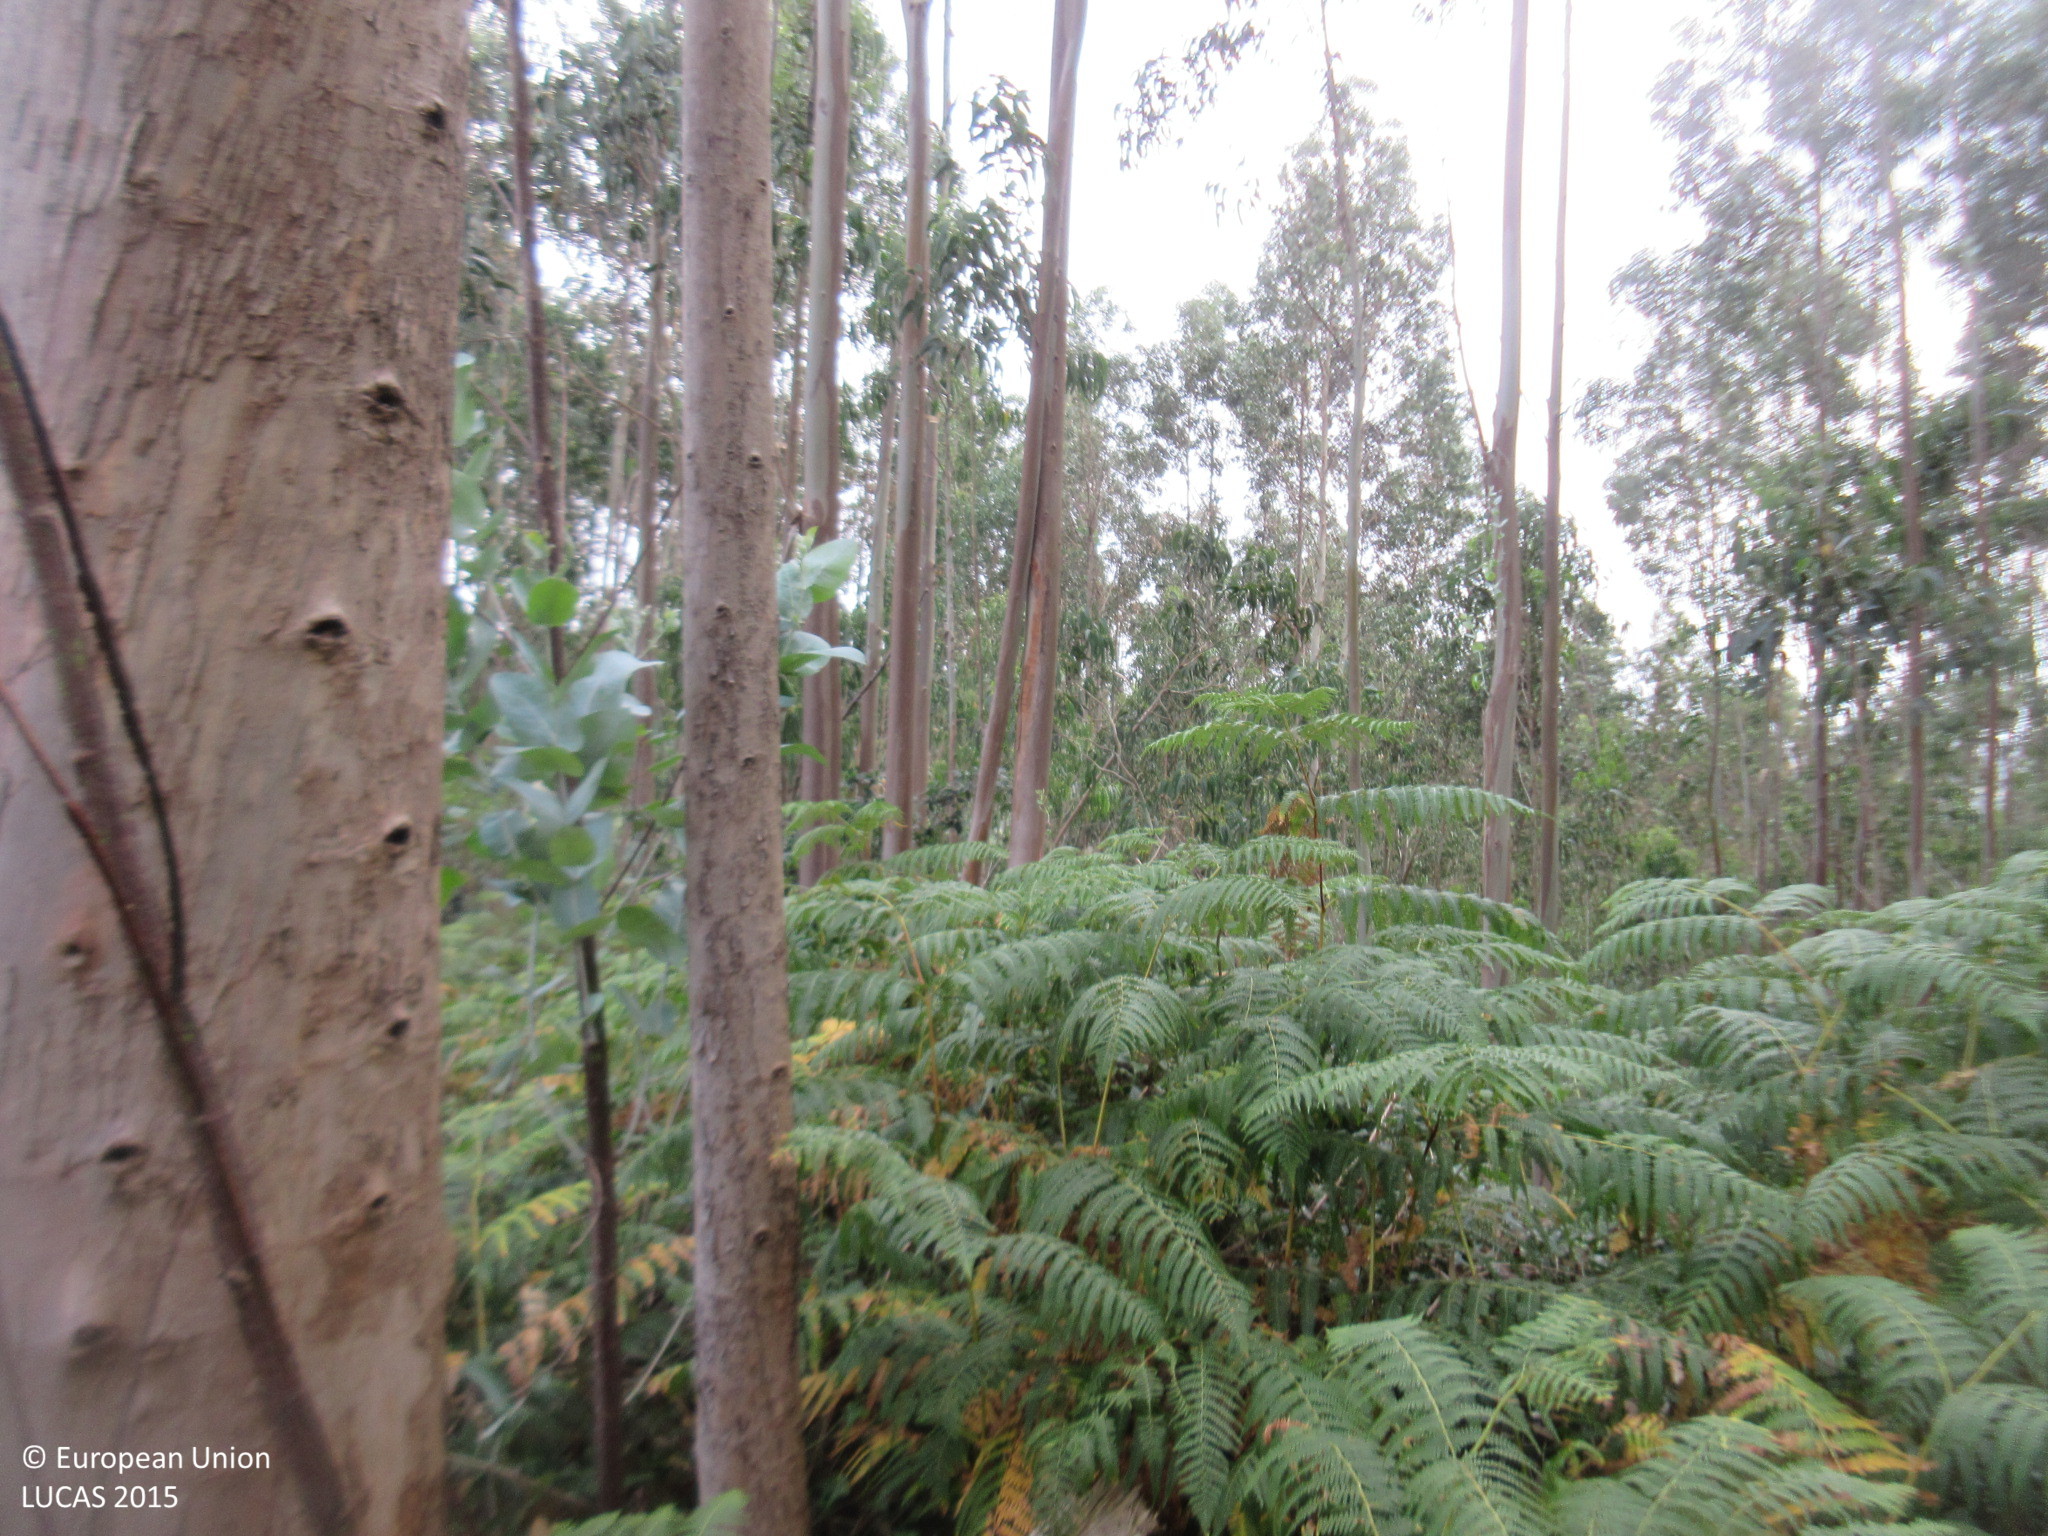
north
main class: Woodland
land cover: Broadleaved woodland
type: exotic forest
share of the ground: > 75 %
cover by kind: broadleaved forest trees 95 %, shrubs 5 %
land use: Forestry
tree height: > 5 m
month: July
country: ES
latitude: 43.3829
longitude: -3.9623
